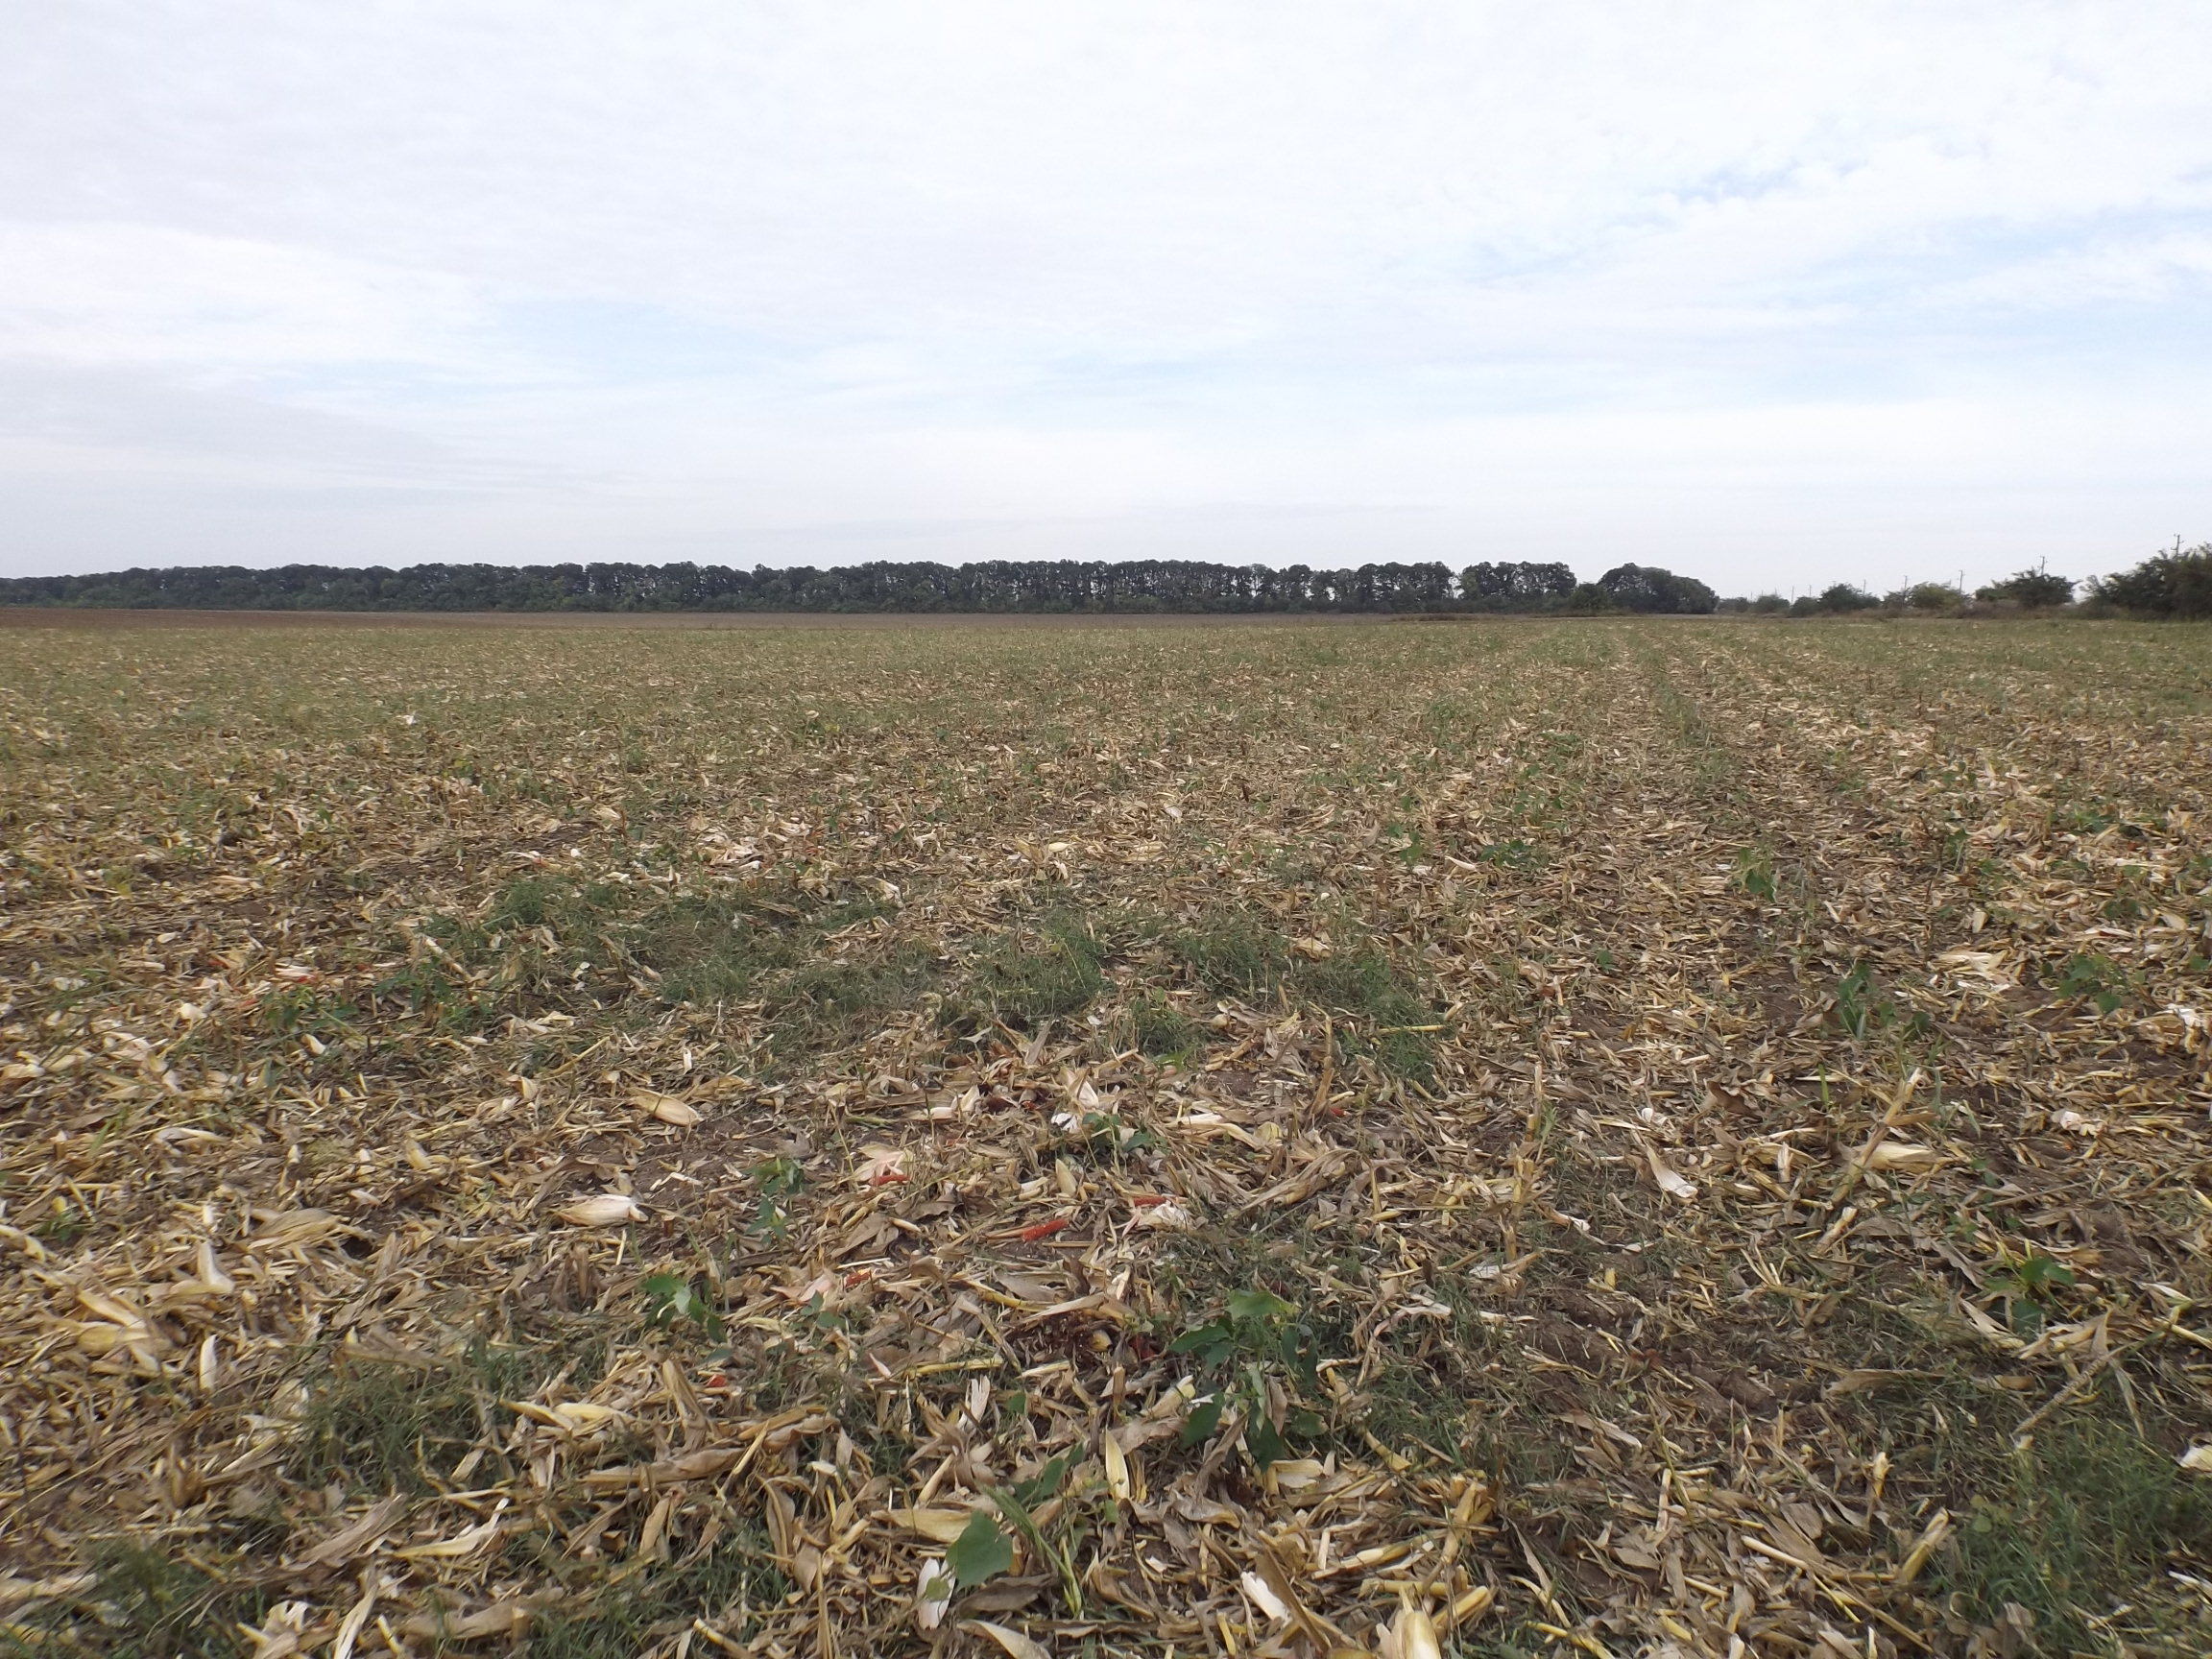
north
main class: Cropland
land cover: Maize
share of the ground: < 10 %
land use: Agriculture (excluding fallow land and kitchen gardens)
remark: Harvested field
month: October
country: BG
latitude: 43.9357
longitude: 26.8488
